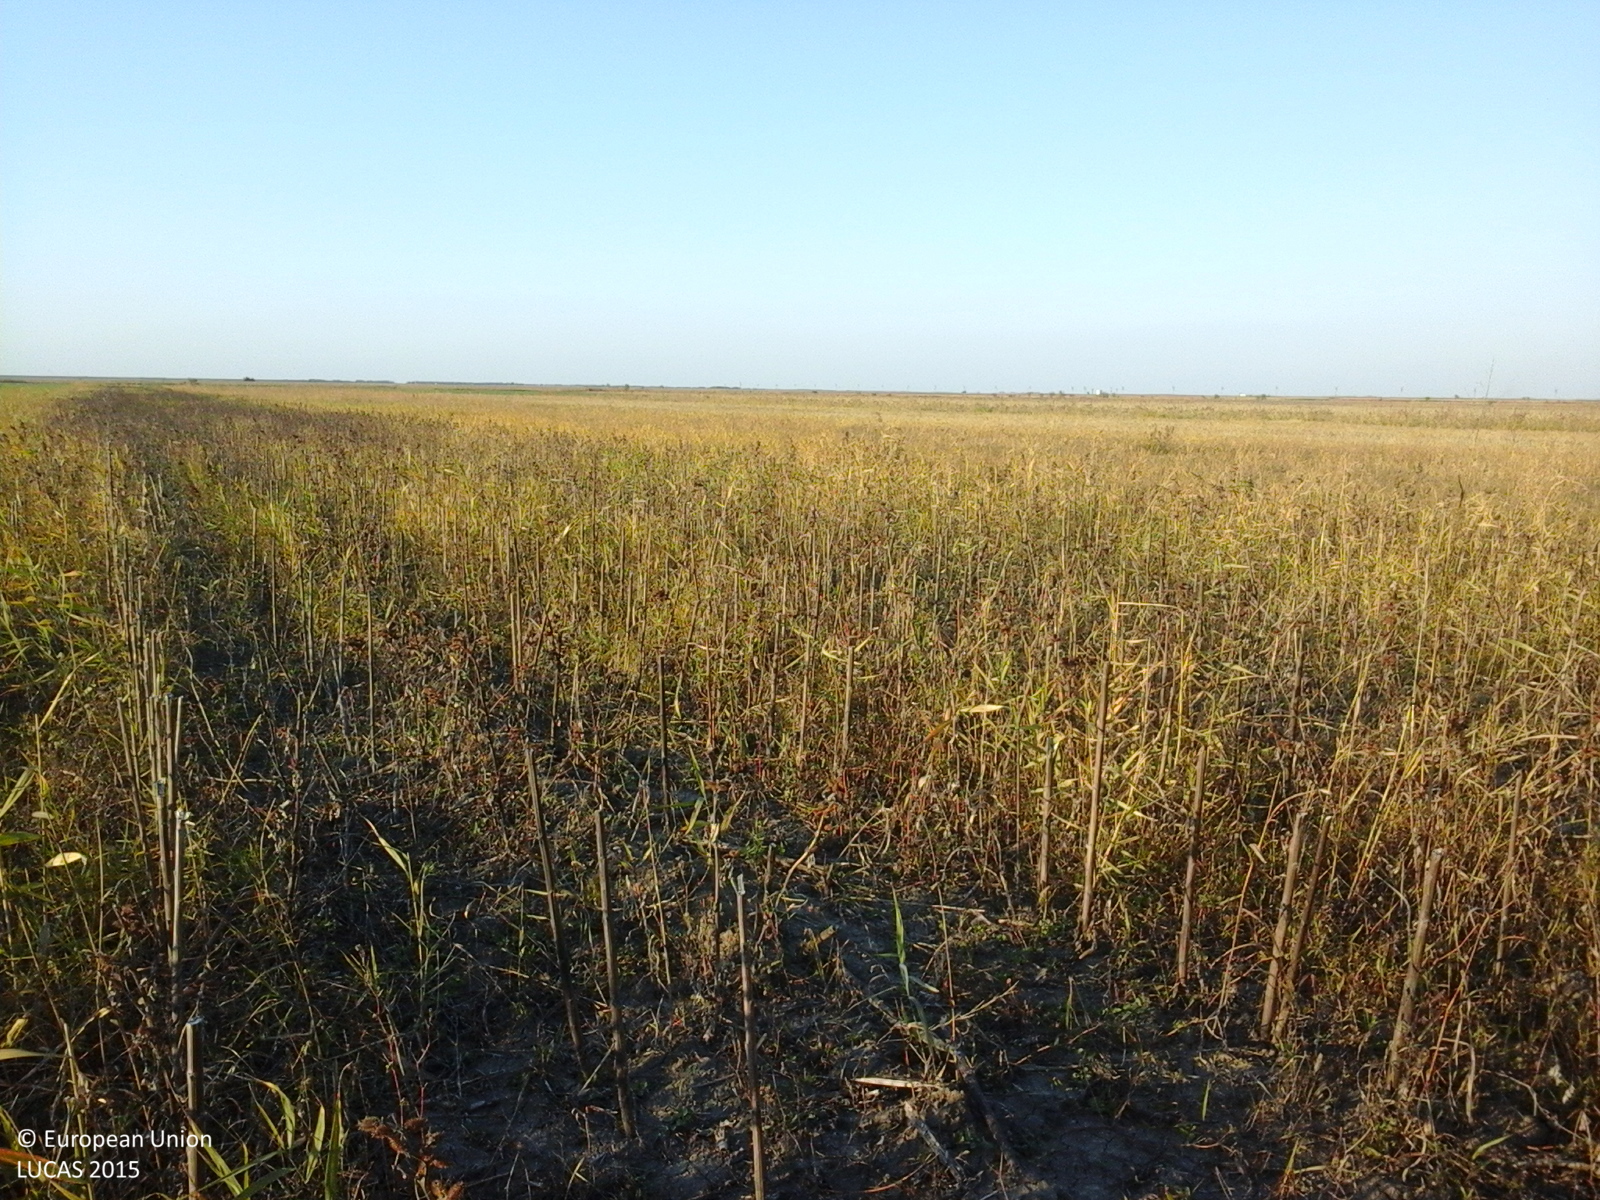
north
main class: Cropland
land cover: Sunflower
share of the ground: > 75 %
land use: Agriculture (excluding fallow land and kitchen gardens)
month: October
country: RO
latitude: 45.3977
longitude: 27.4608
